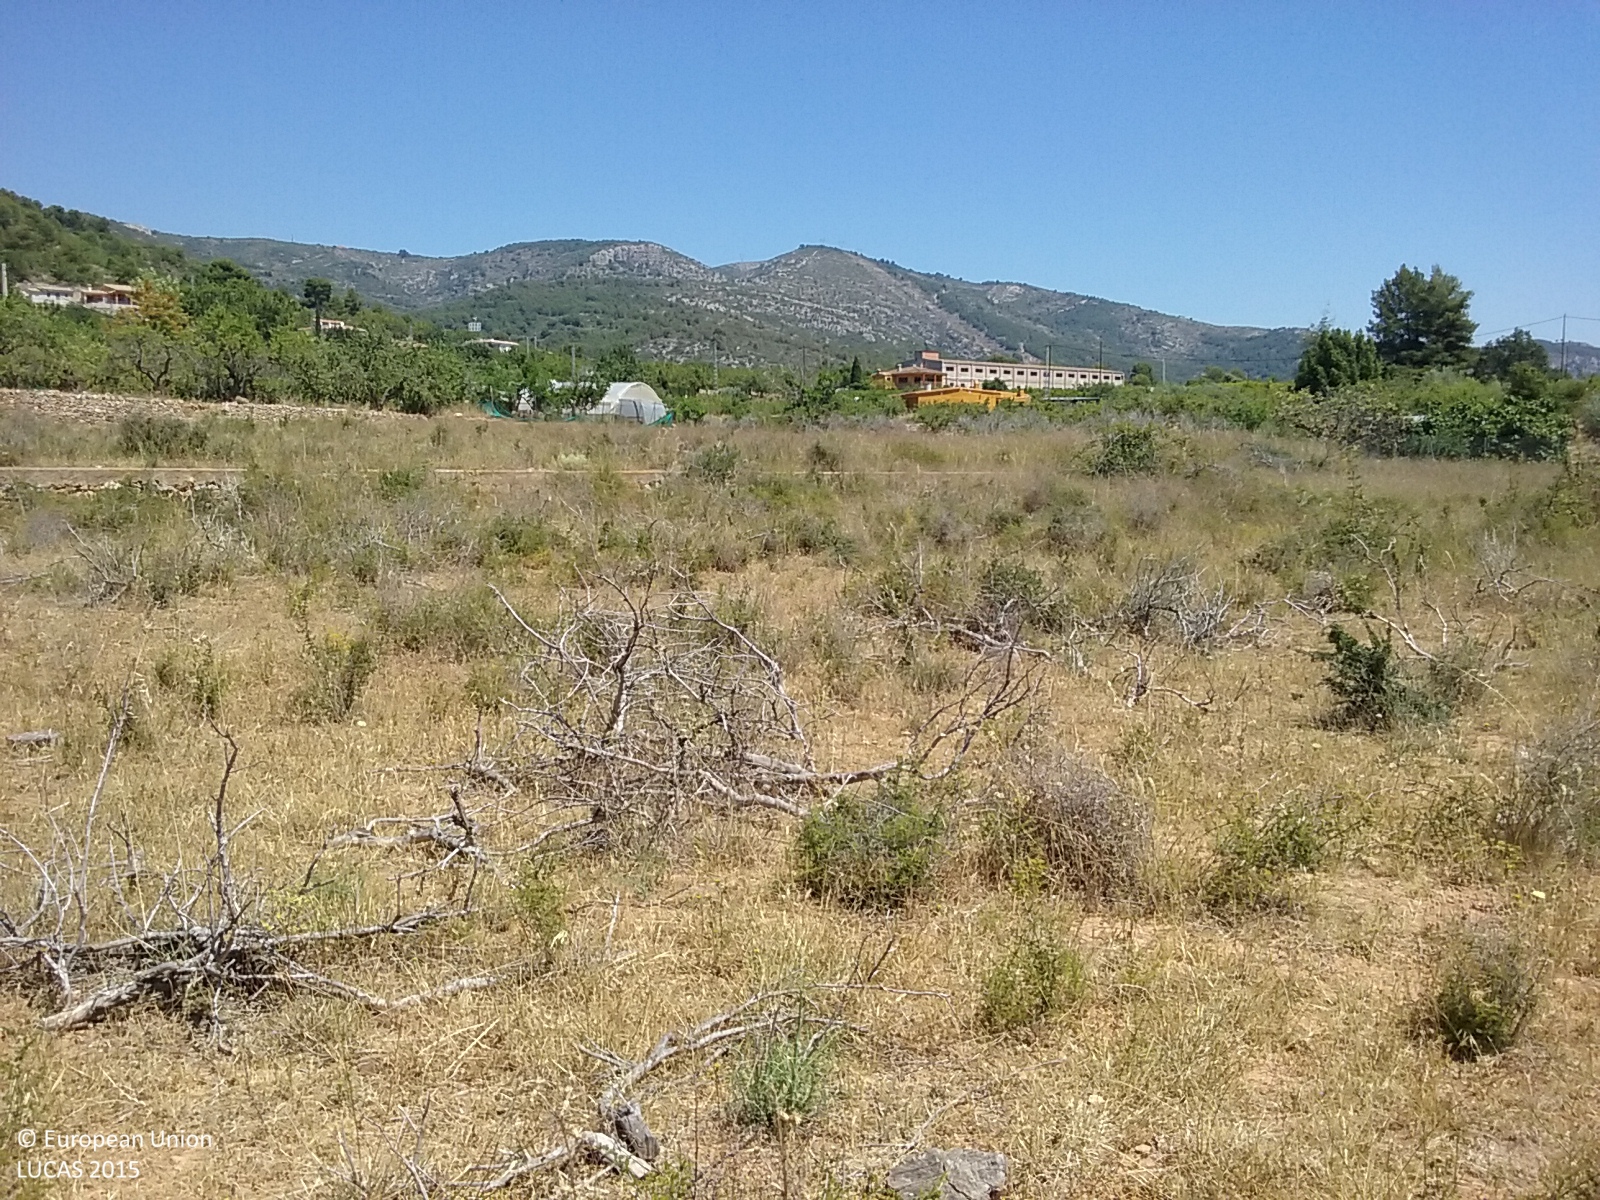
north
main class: Shrubland
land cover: Shrubland without tree cover
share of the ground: 10 - 25 %
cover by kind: herbaceous plants 80 %, shrubs 15 %, unconsolidated bare surface 5 %
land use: Abandoned areas
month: June
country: ES
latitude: 40.0598
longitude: -0.0488
